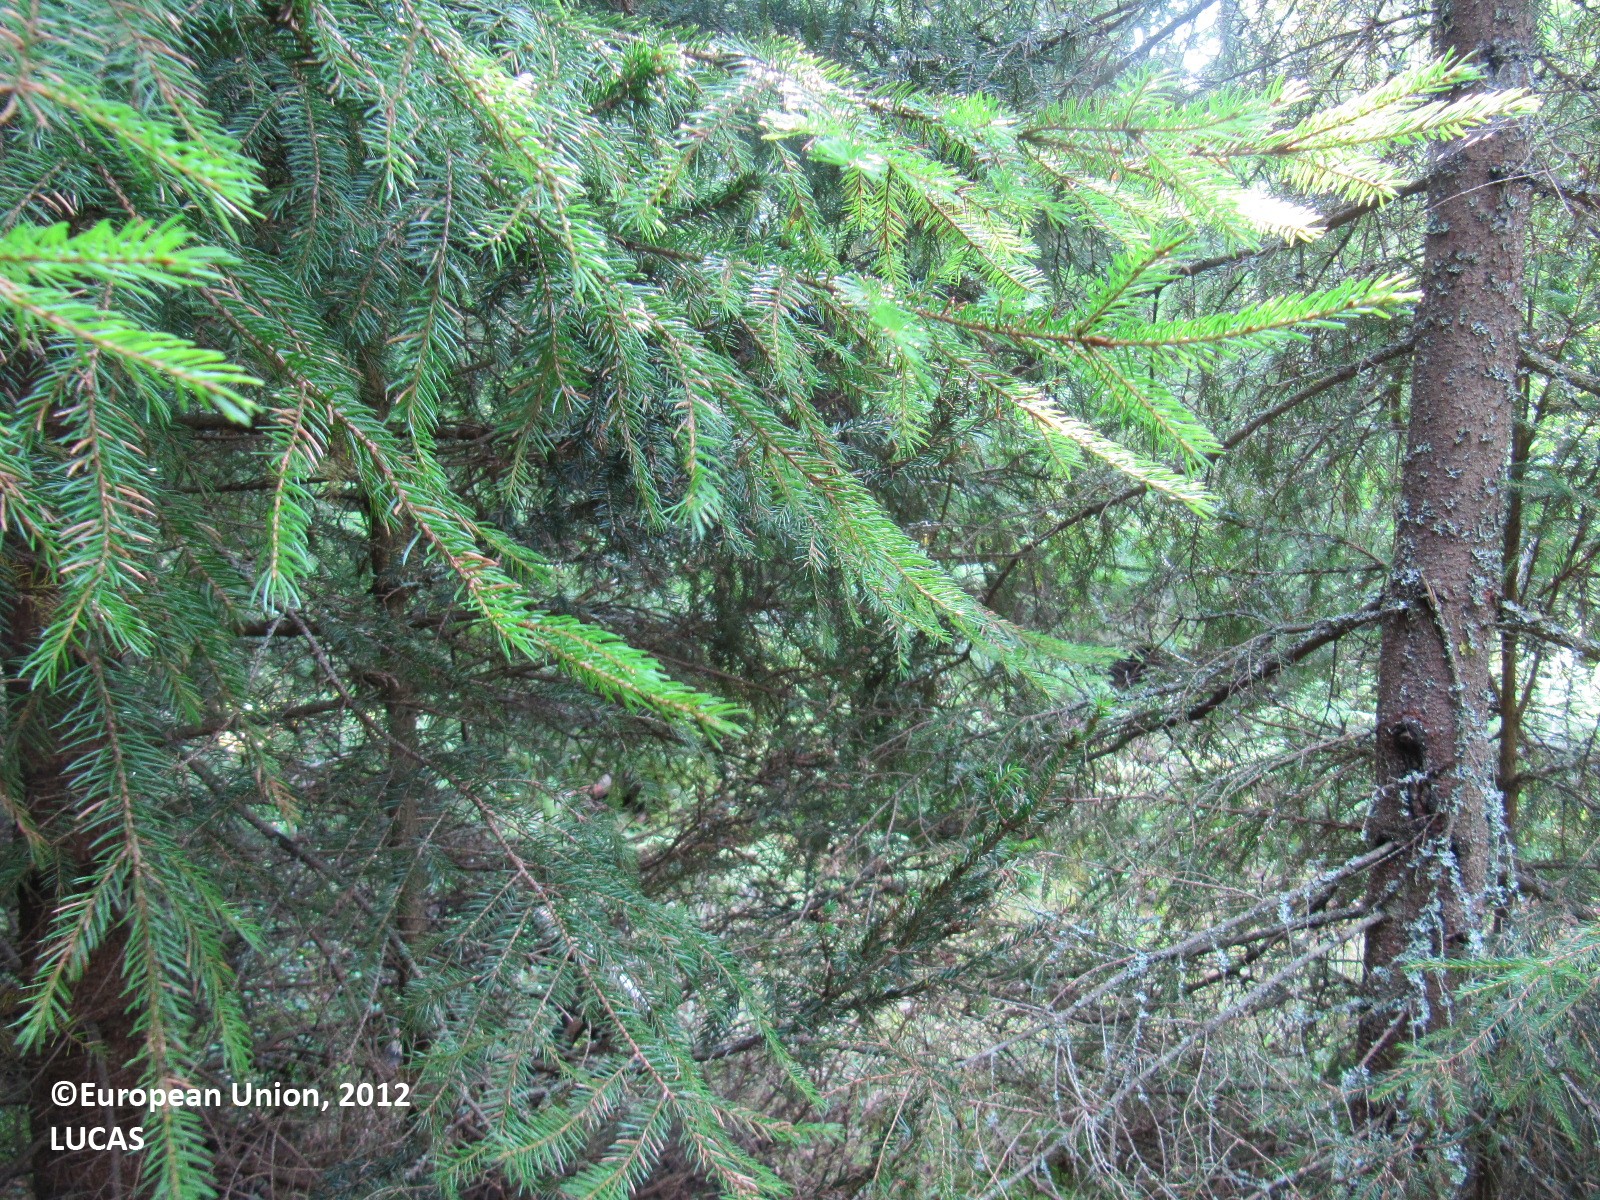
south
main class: Woodland
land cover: Spruce dominated coniferous woodland
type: boreal forest
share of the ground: > 75 %
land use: Forestry
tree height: > 5 m
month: August
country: FI
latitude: 61.1709
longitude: 22.9561
